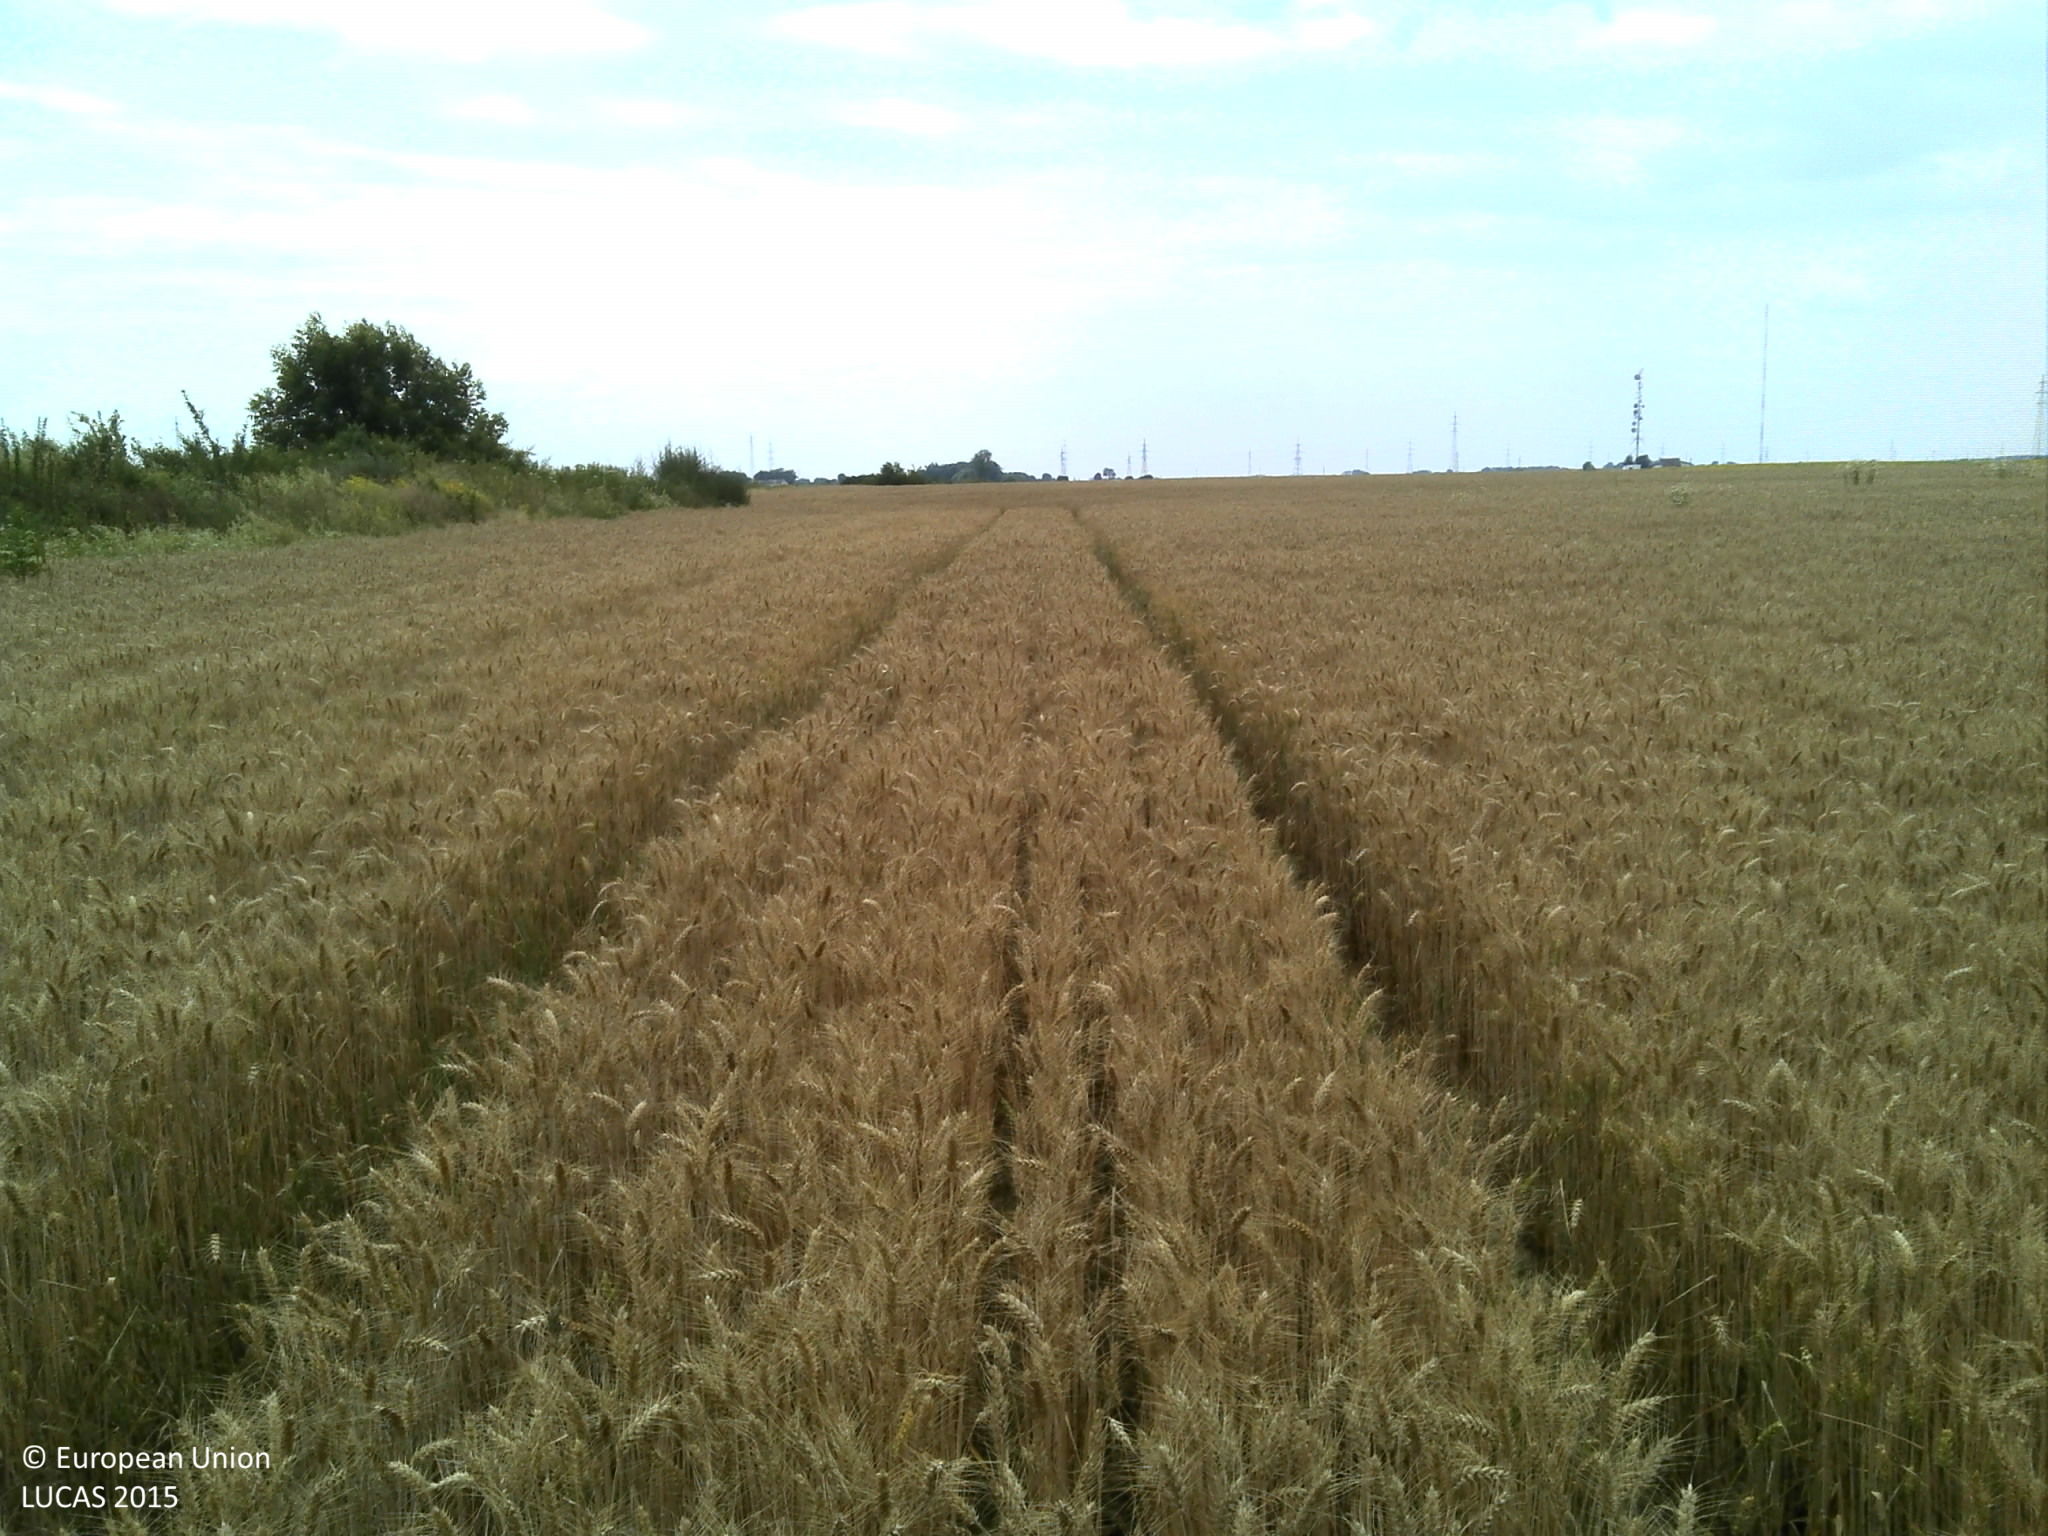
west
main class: Cropland
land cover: Barley
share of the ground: > 75 %
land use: Agriculture (excluding fallow land and kitchen gardens)
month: June
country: HR
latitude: 45.5514
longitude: 18.6022
